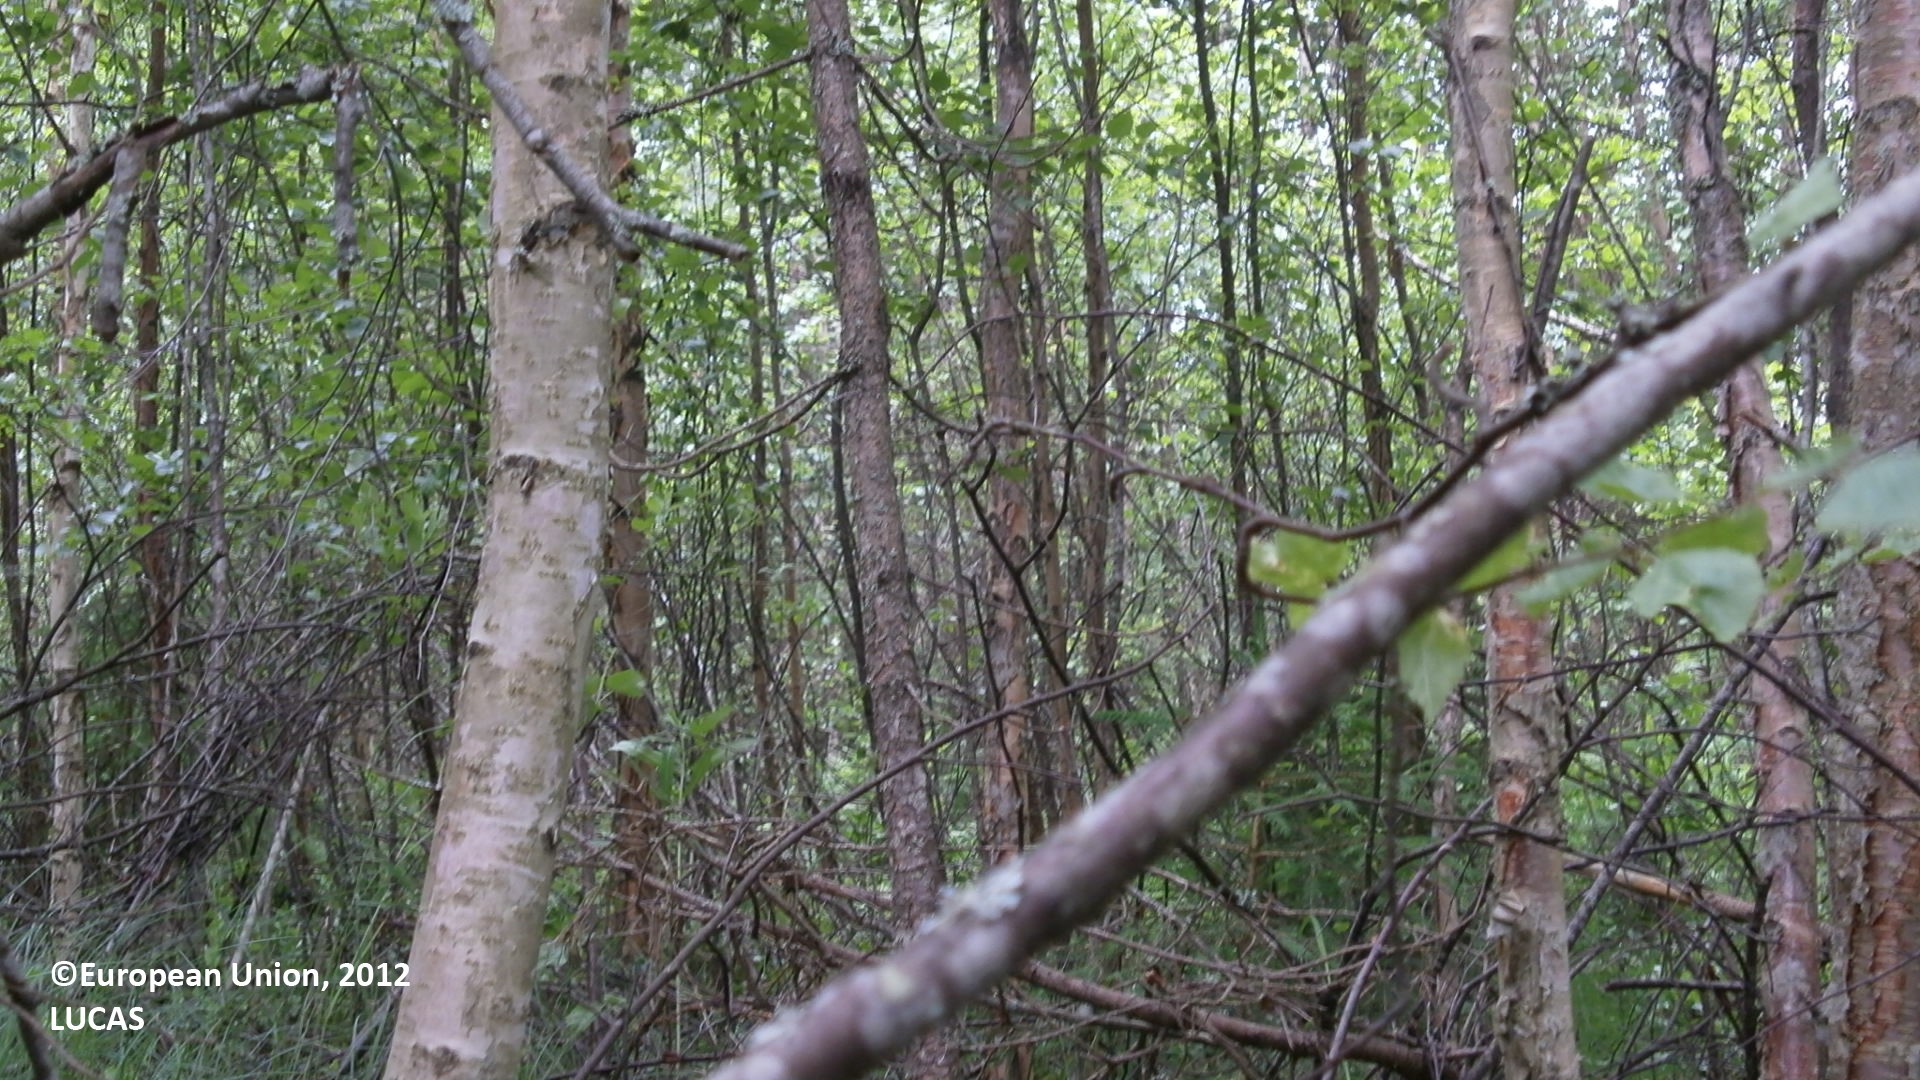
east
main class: Woodland
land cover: Broadleaved woodland
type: boreal forest
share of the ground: > 75 %
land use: Forestry
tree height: > 5 m
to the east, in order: Ditches and canals; Broadleaved woodland; Ditches and canals; Broadleaved woodland; Ditches and canals; Broadleaved woodland; Other mixed woodland; Broadleaved woodland; Ditches and canals; Abandoned hedges; Temporary grasslands; Ditches and canals; Temporary grasslands; Ditches and canals; Temporary grasslands; Ditches and canals; Pine dominated mixed woodland; Ditches and canals; Pine dominated mixed woodland; Ditches and canals; Pine dominated mixed woodland
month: June
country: FI
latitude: 64.6067
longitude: 25.1499
